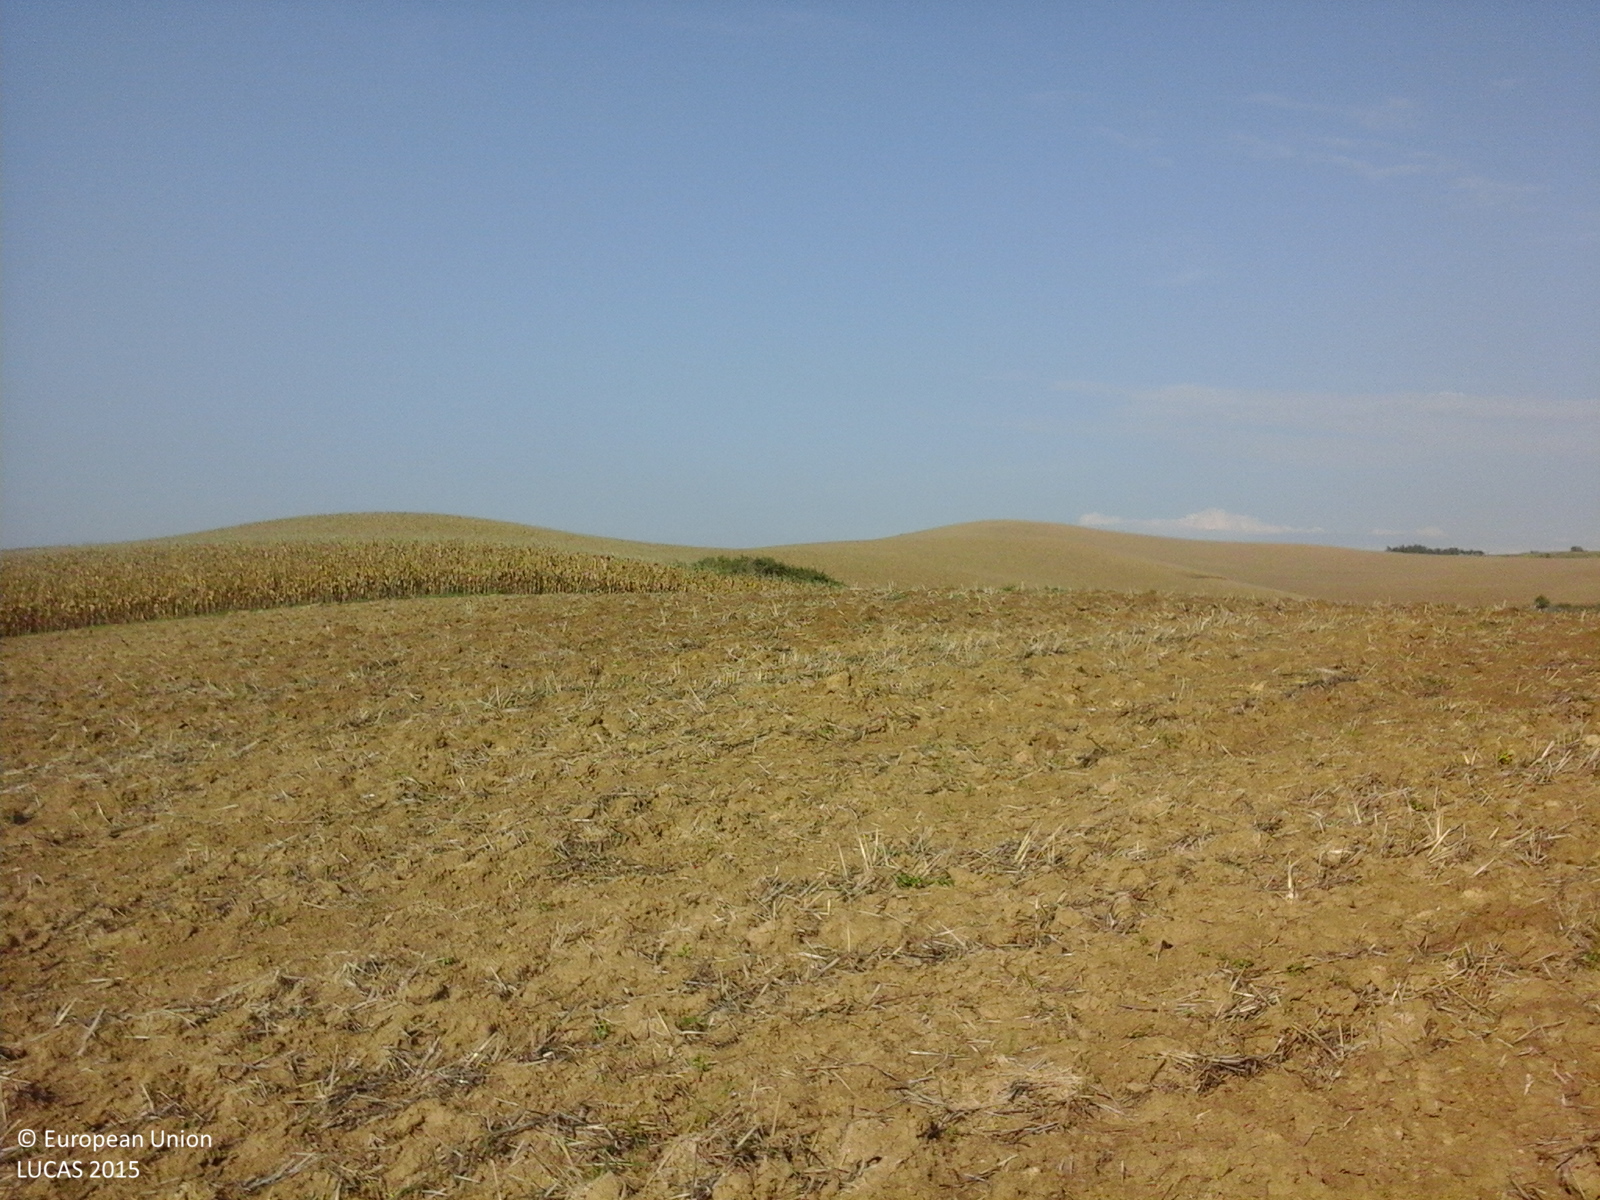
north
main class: Cropland
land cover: Common wheat
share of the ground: < 10 %
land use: Agriculture (excluding fallow land and kitchen gardens)
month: October
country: RO
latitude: 46.6582
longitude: 24.3420
